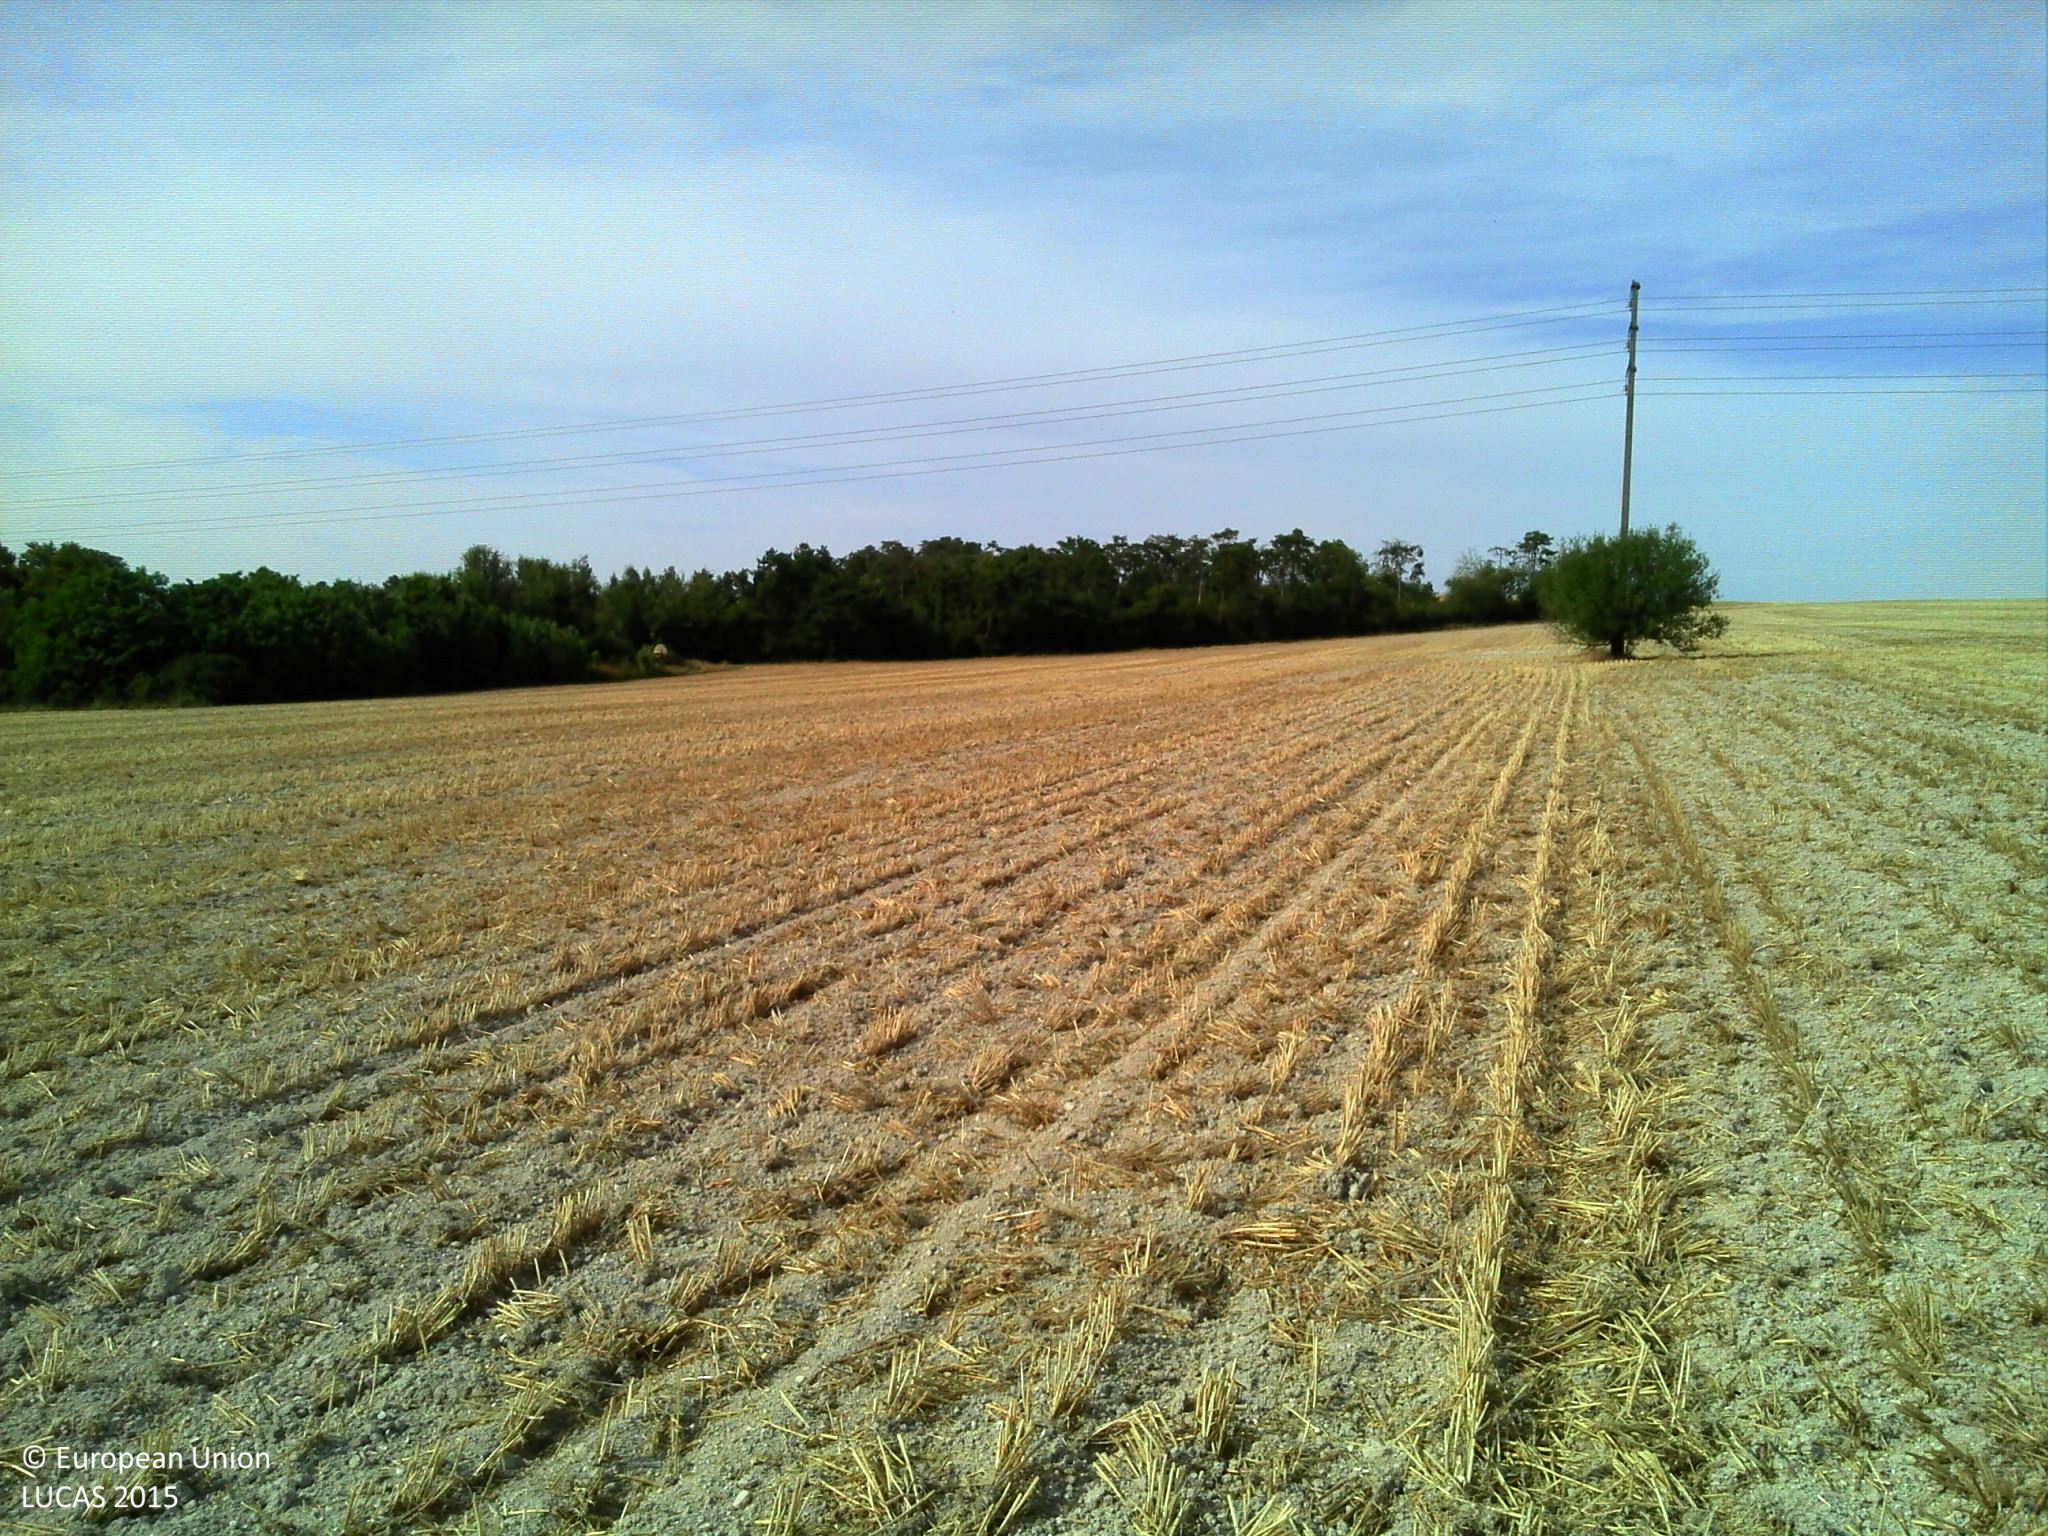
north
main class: Cropland
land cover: Common wheat
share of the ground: > 75 %
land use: Agriculture (excluding fallow land and kitchen gardens)
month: August
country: FR
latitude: 49.2217
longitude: 4.1326
